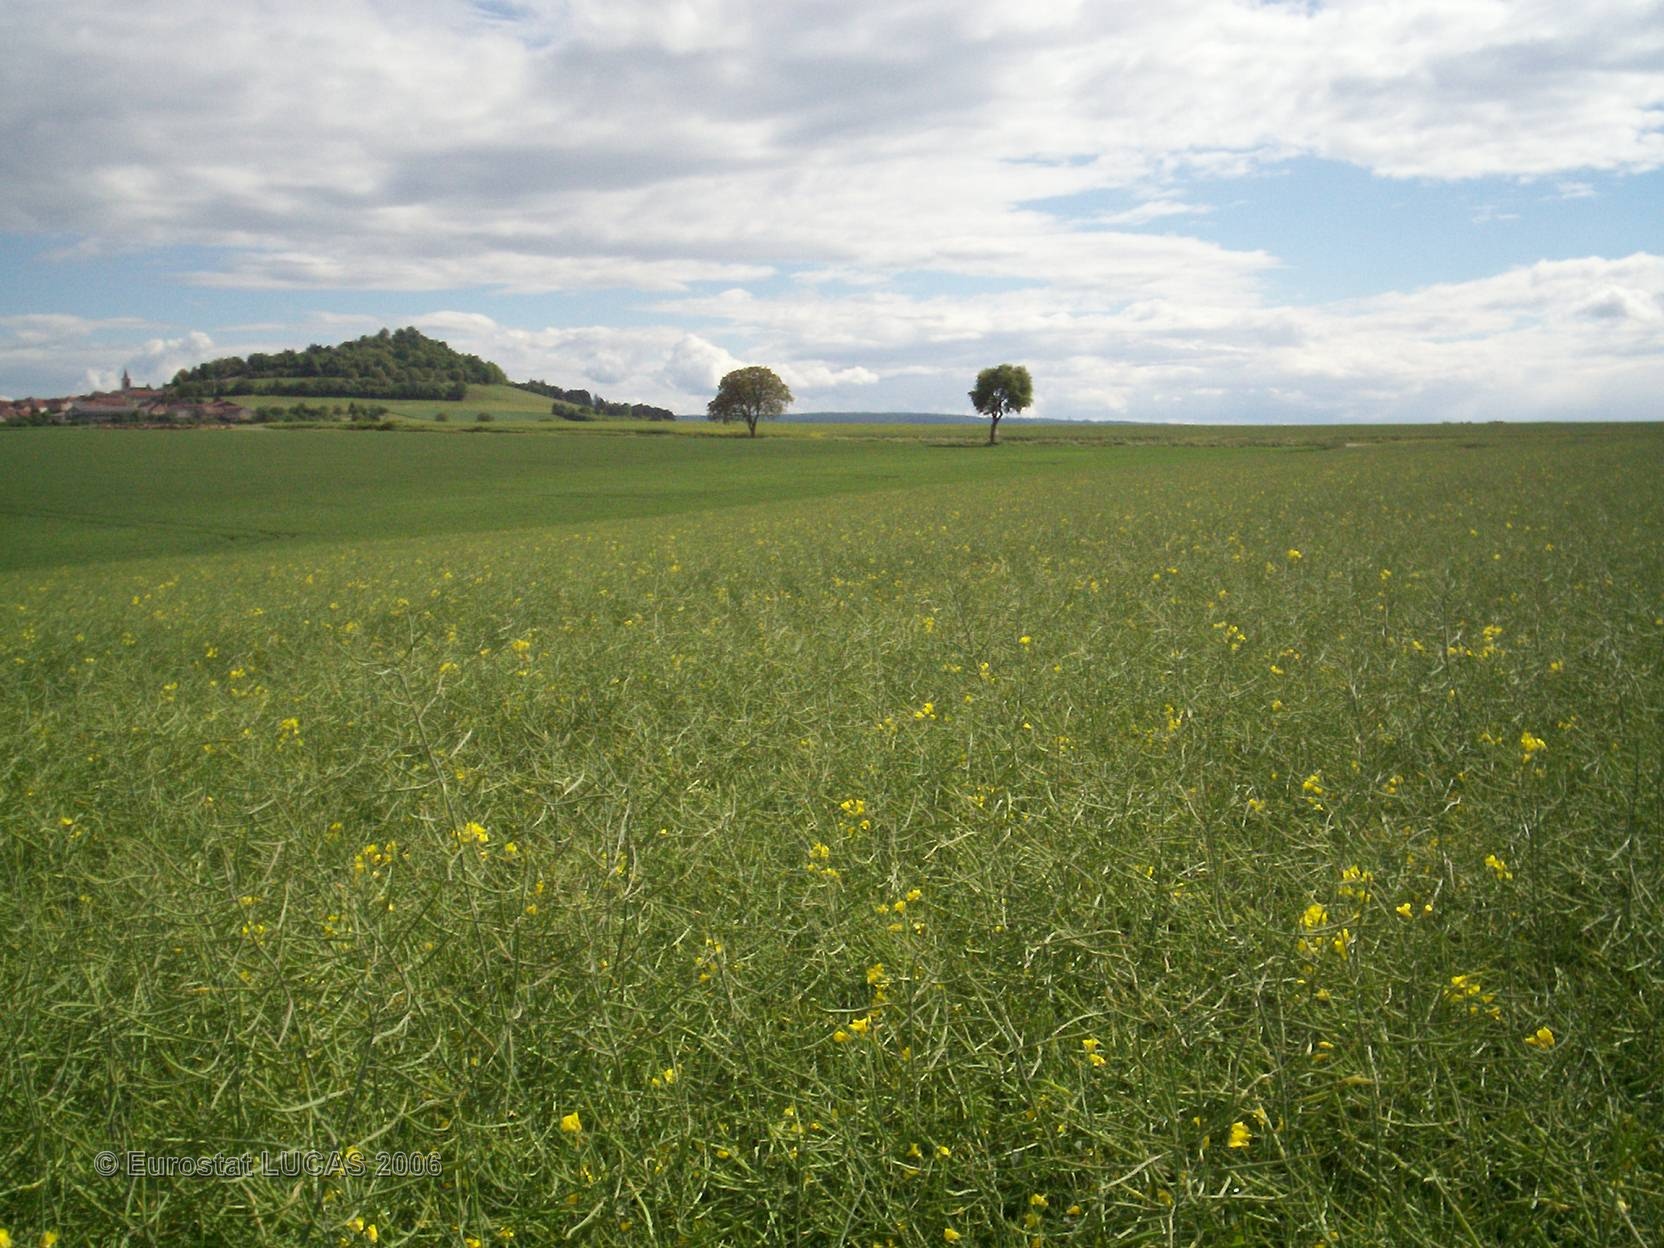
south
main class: Cropland
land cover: Rape and turnip rape
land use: Agriculture (excluding fallow land and kitchen gardens)
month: May
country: FR
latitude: 47.5519
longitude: 5.0169
